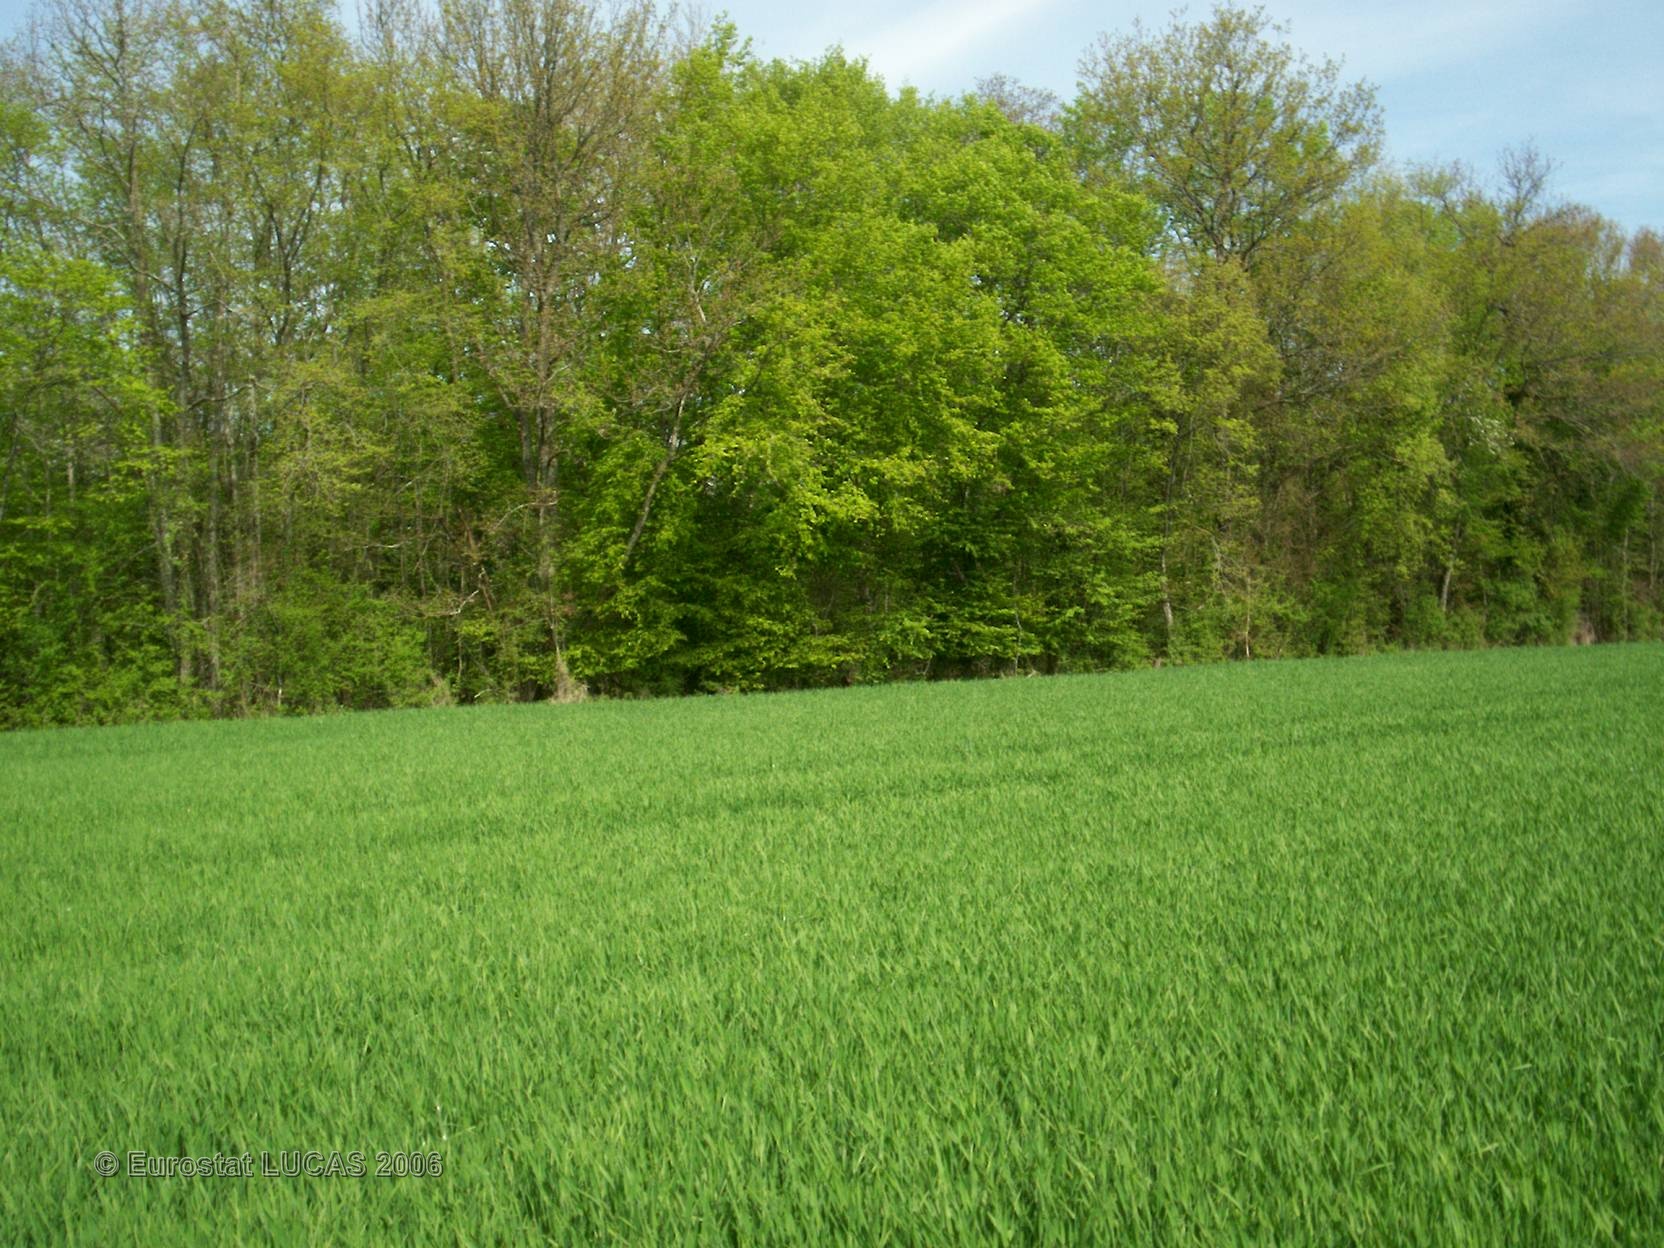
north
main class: Cropland
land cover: Barley
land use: Agriculture (excluding fallow land and kitchen gardens)
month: May
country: FR
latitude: 47.8521
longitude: 4.5055
